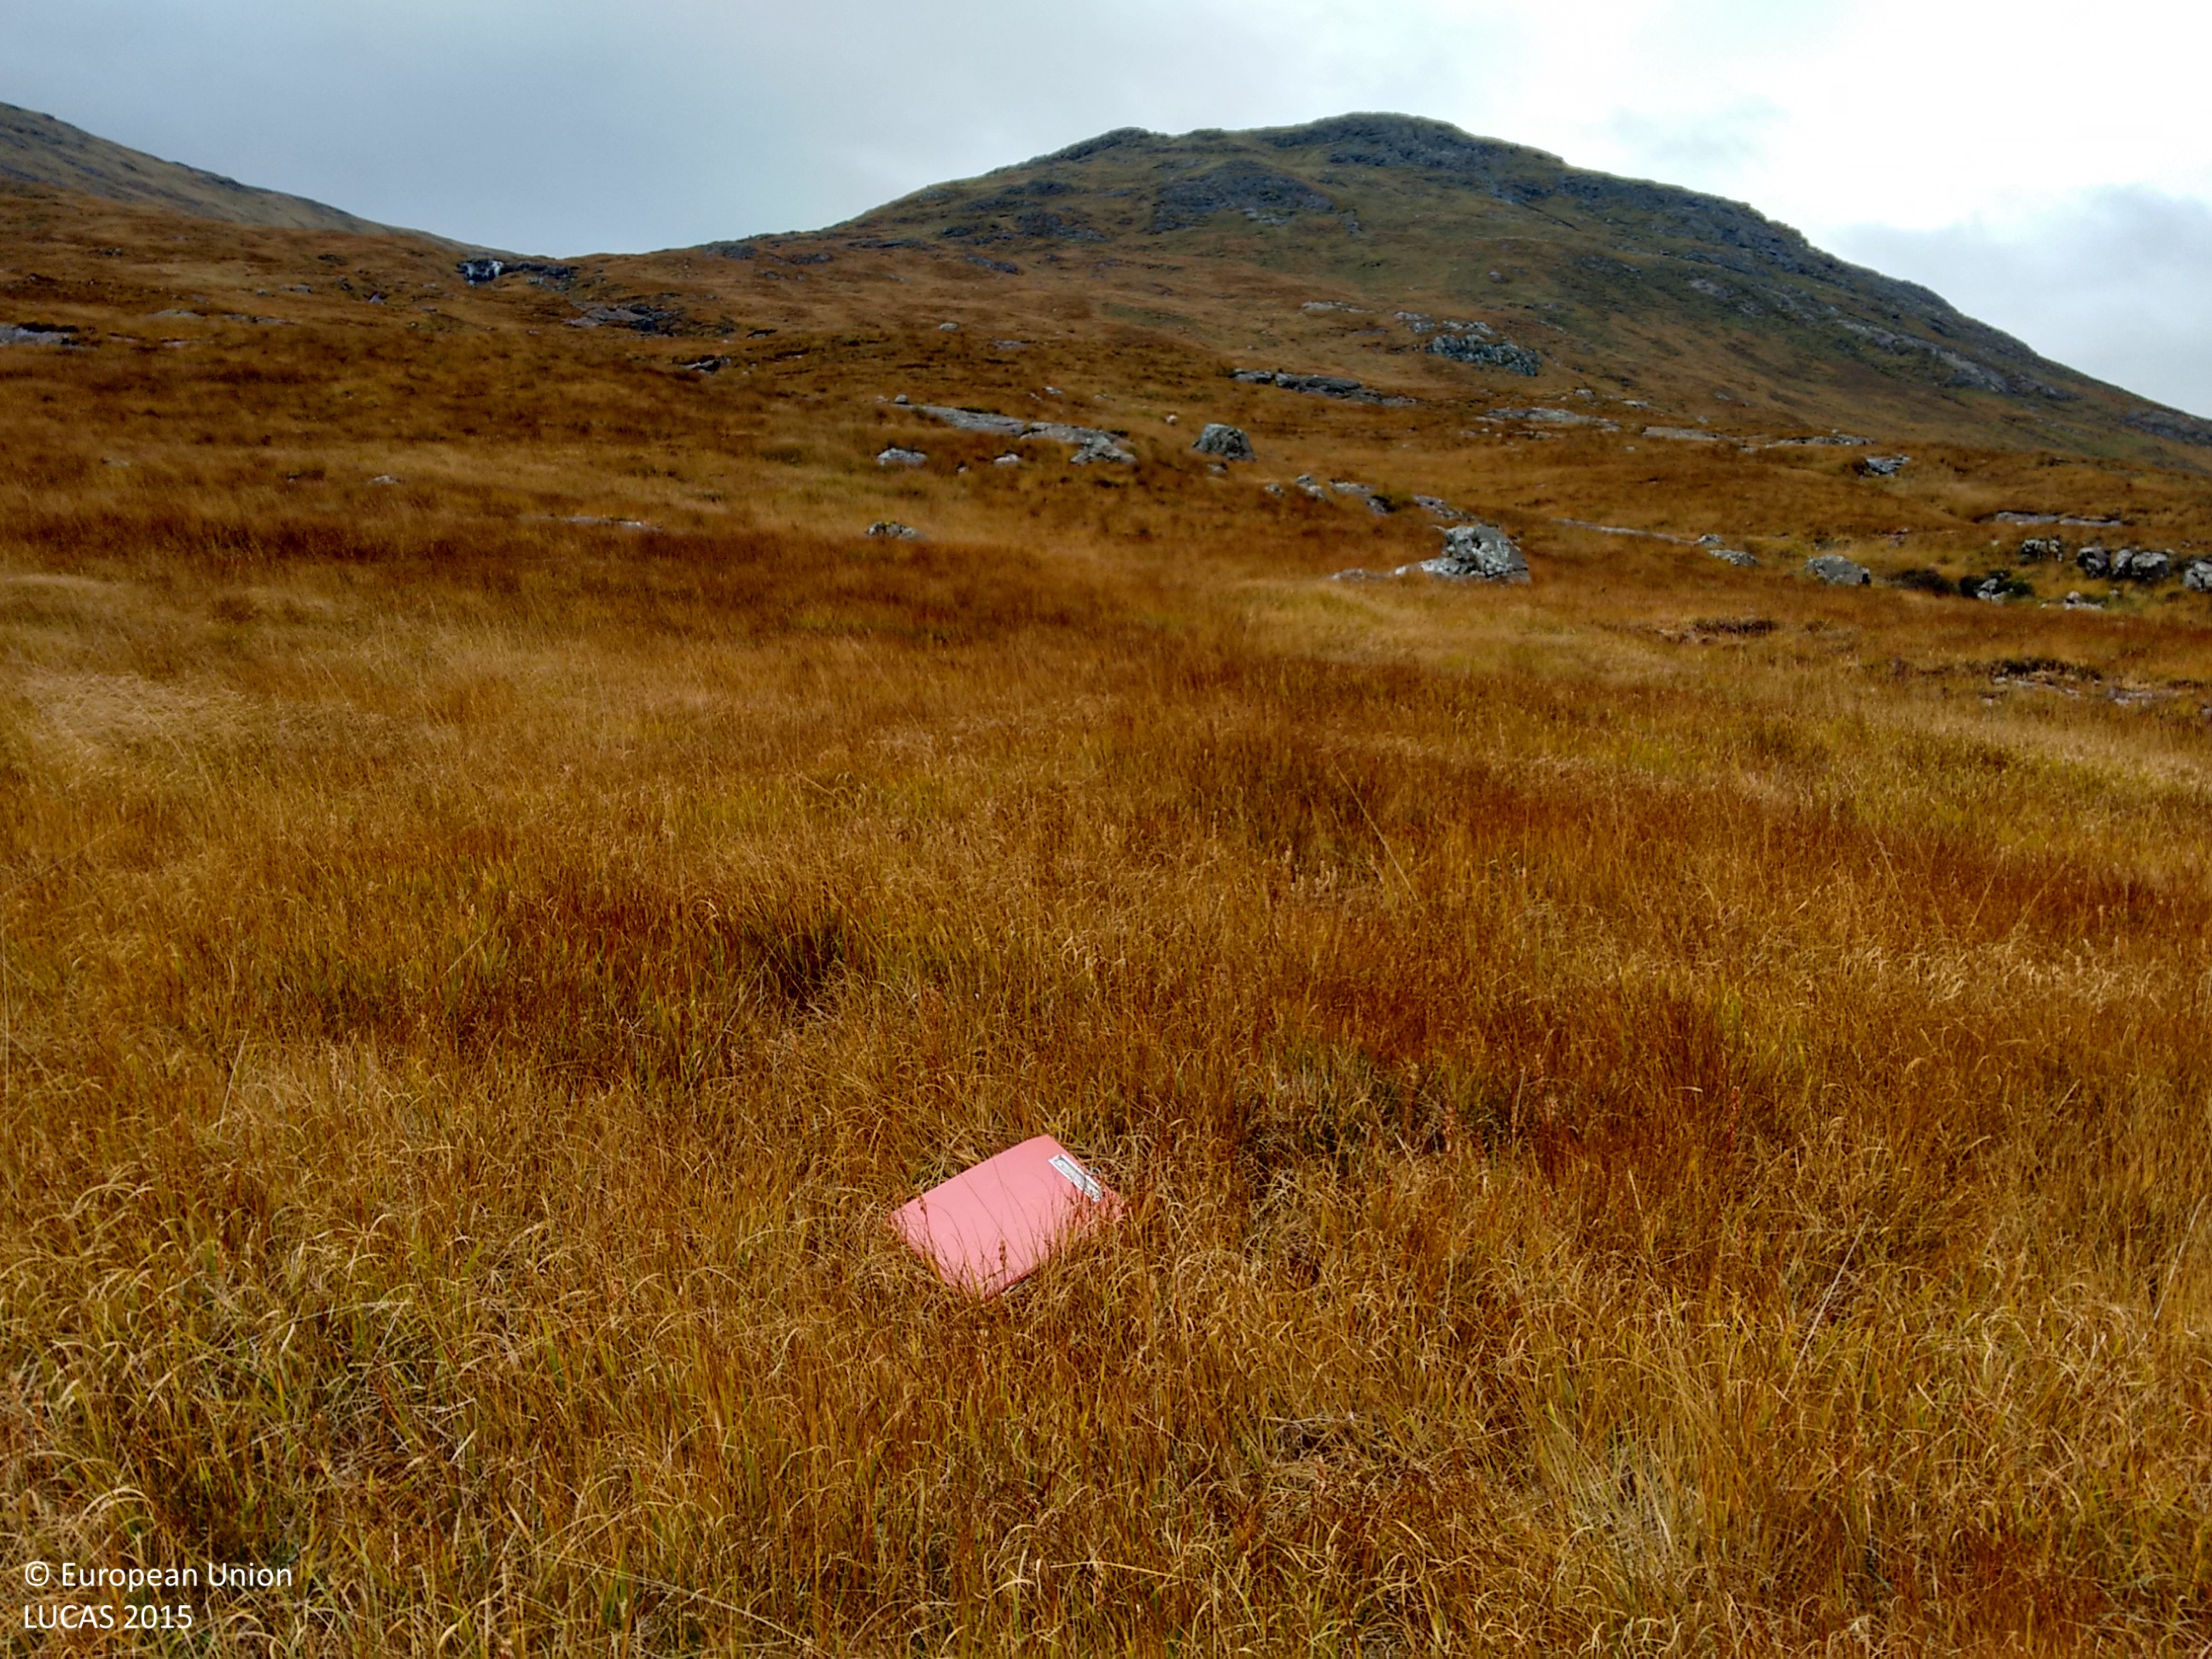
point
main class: Grassland
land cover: Grassland without tree/shrub cover
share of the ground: > 75 %
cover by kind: herbaceous plants 100 %
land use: Semi-natural and natural areas not in use
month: October
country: GB
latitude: 56.4292
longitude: -5.8087
